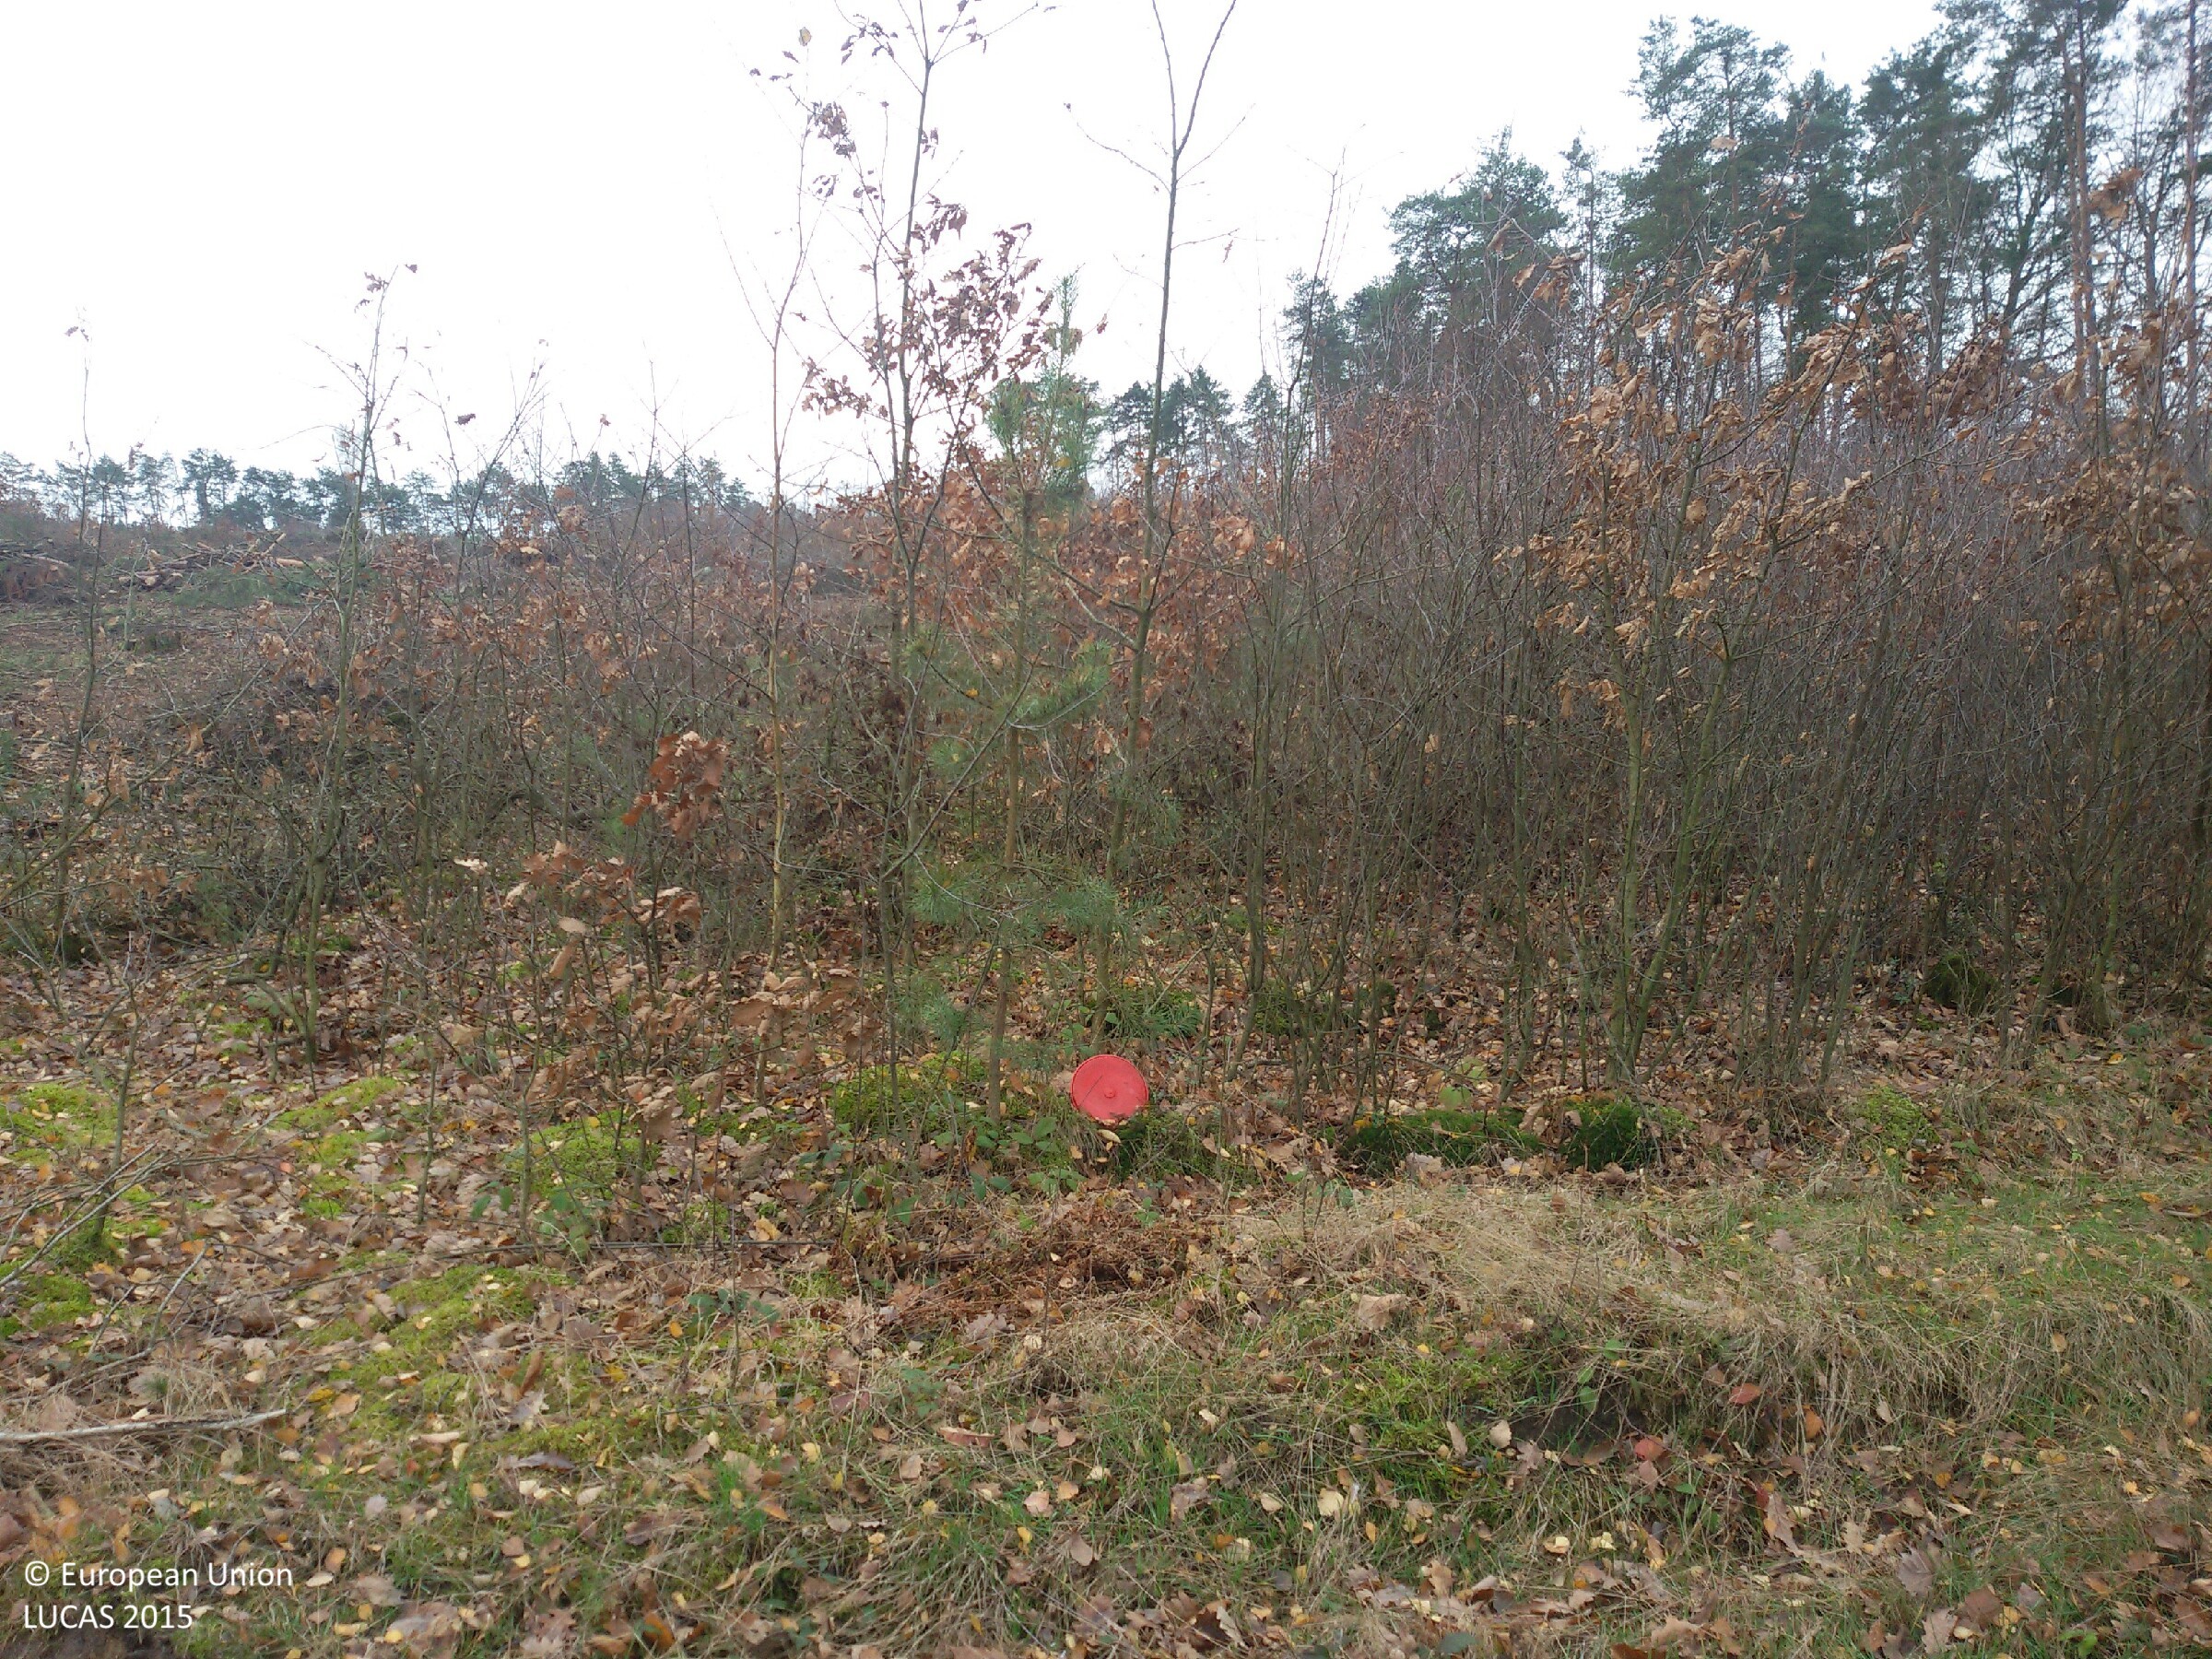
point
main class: Woodland
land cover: Pine dominated mixed woodland
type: hemiboreal forest and nemoral coniferous forest and mixed broadleaved-coniferous forest
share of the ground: > 75 %
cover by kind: coniferous forest trees 55 %, broadleaved forest trees 25 %, herbaceous plants 10 %, unconsolidated bare surface 10 %
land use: Forestry
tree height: > 5 m
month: May
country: PL
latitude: 51.6906
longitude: 21.6698
